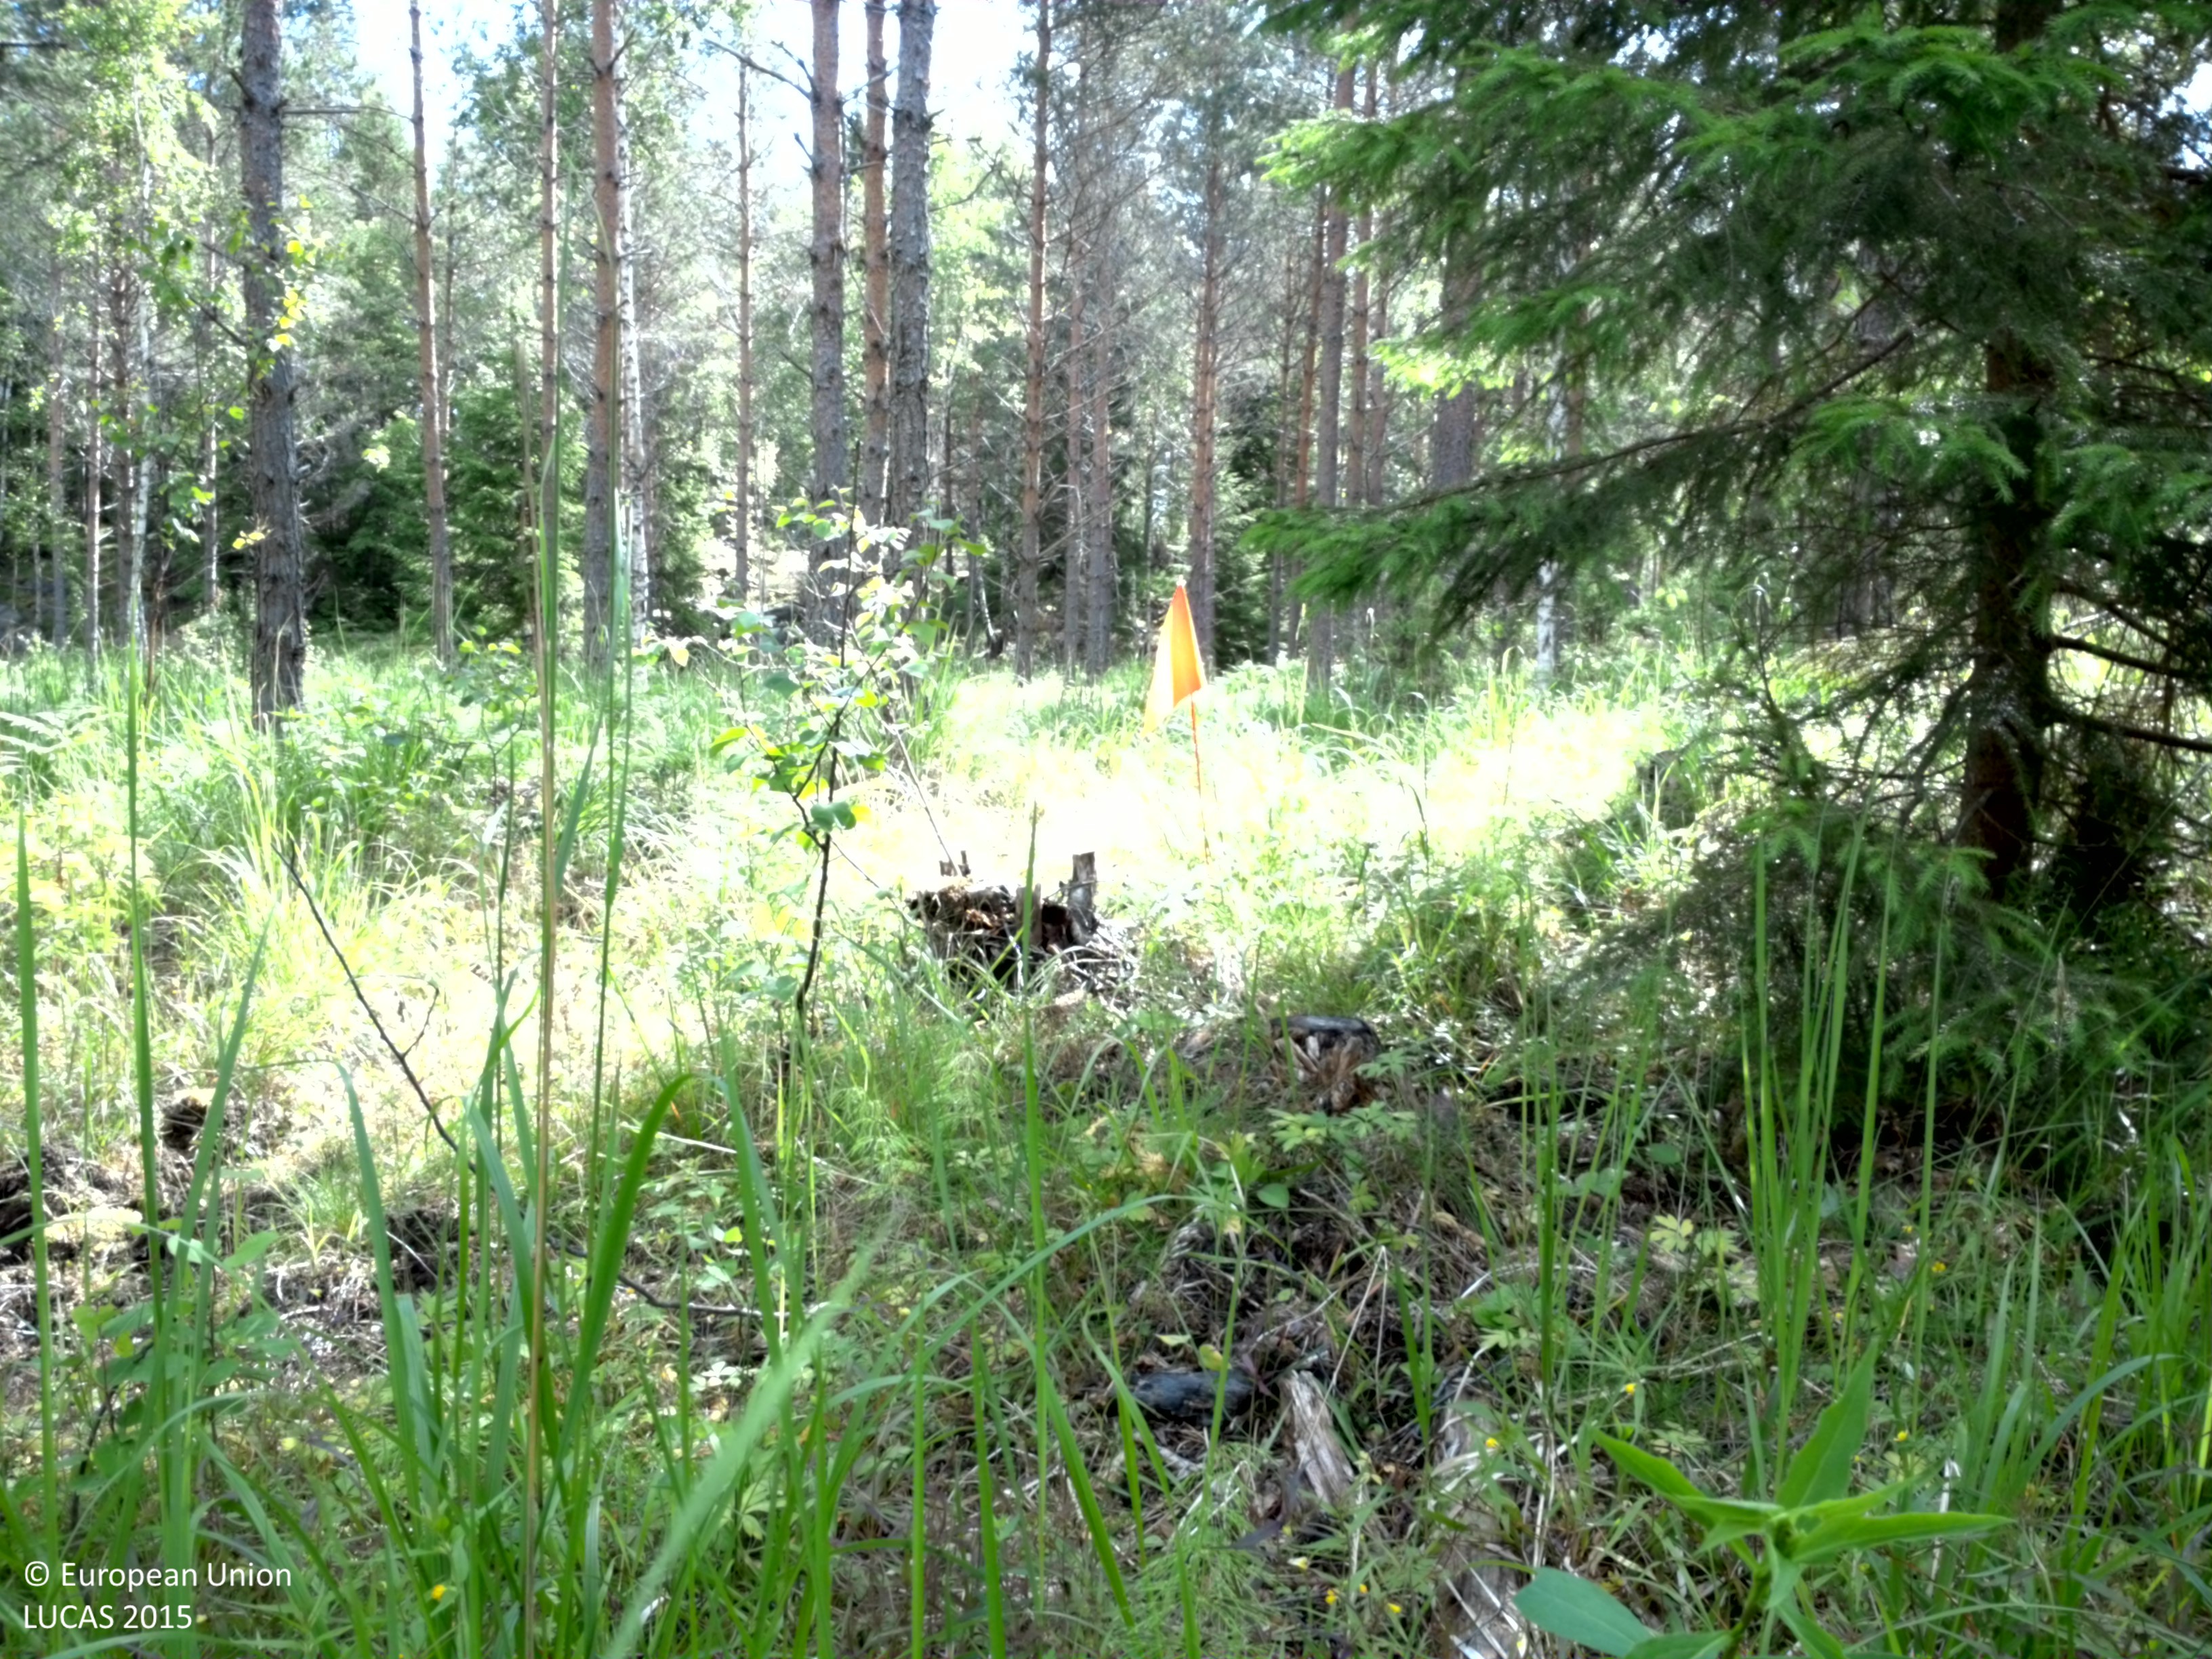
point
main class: Woodland
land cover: Pine dominated mixed woodland
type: boreal forest
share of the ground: 50 - 75 %
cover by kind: coniferous forest trees 45 %, herbaceous plants 25 %, broadleaved forest trees 15 %, lichens and mosses 15 %
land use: Forestry
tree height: > 5 m
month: June
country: SE
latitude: 60.1091
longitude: 18.4338
